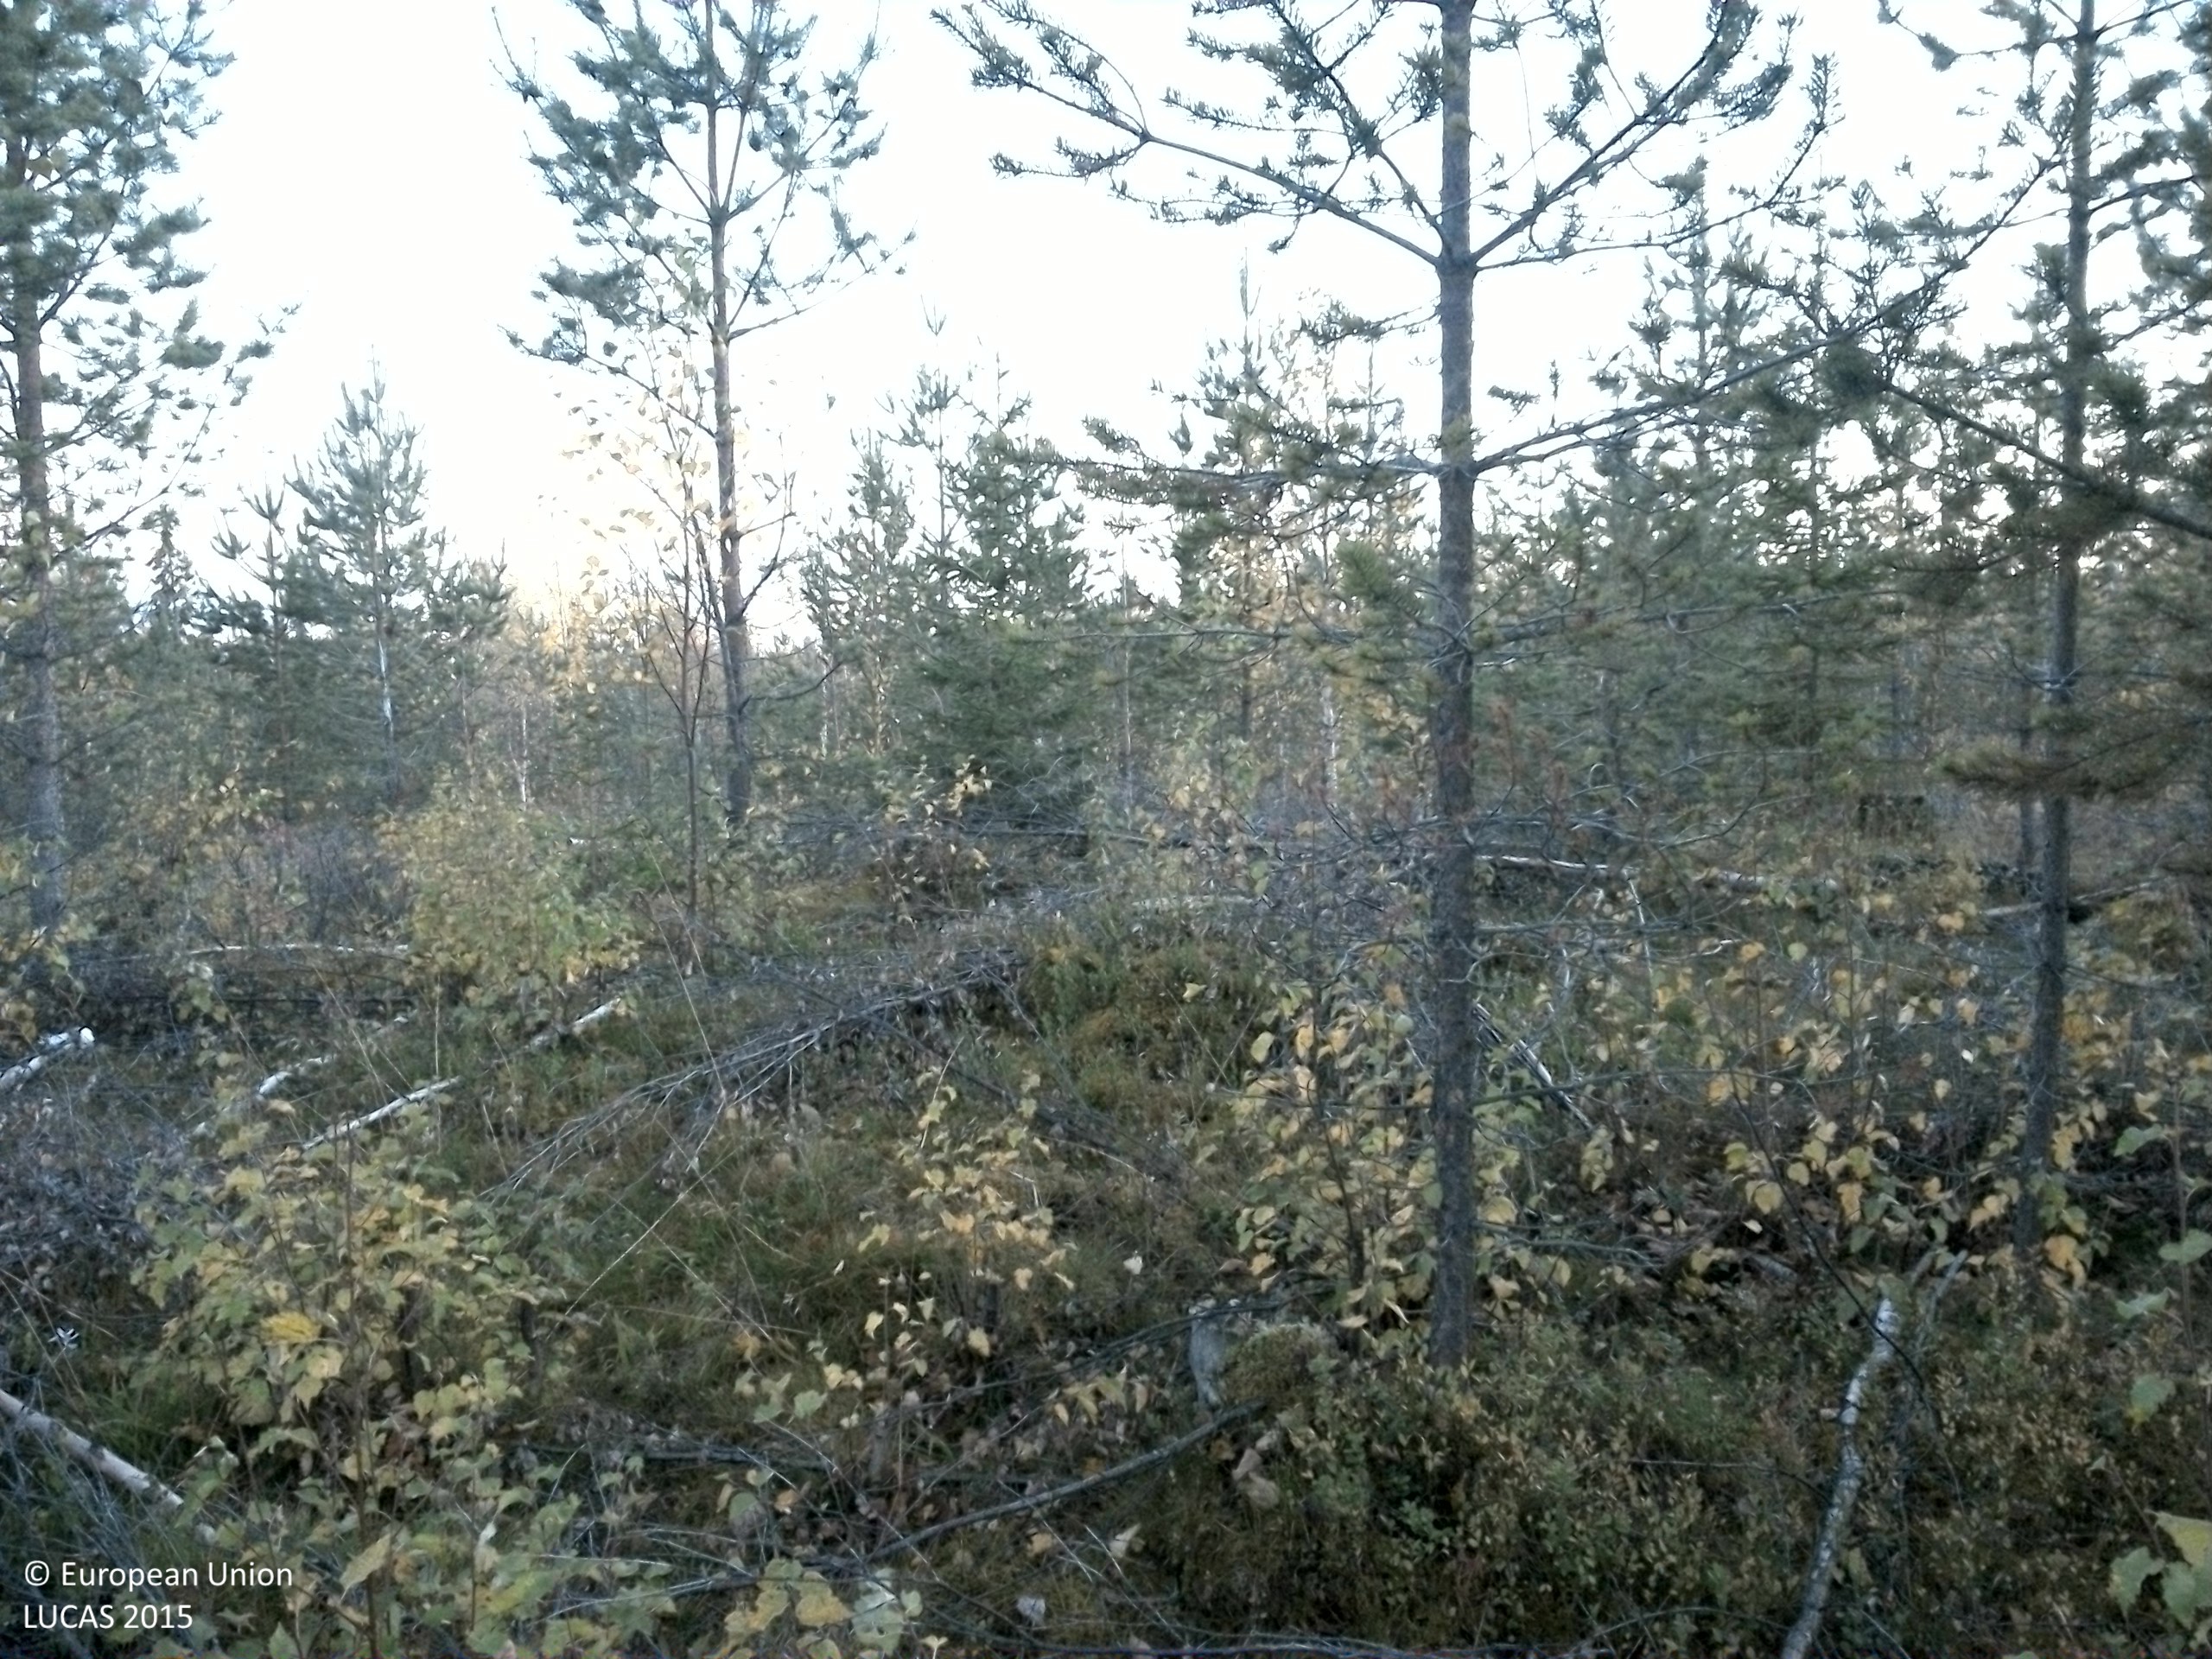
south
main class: Woodland
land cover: Pine dominated coniferous woodland
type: boreal forest
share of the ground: 25 - 50 %
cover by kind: coniferous forest trees 35 %, shrubs 30 %, lichens and mosses 15 %, broadleaved forest trees 10 %, herbaceous plants 10 %
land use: Forestry
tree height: < 5 m
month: October
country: SE
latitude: 64.3166
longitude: 16.1116
